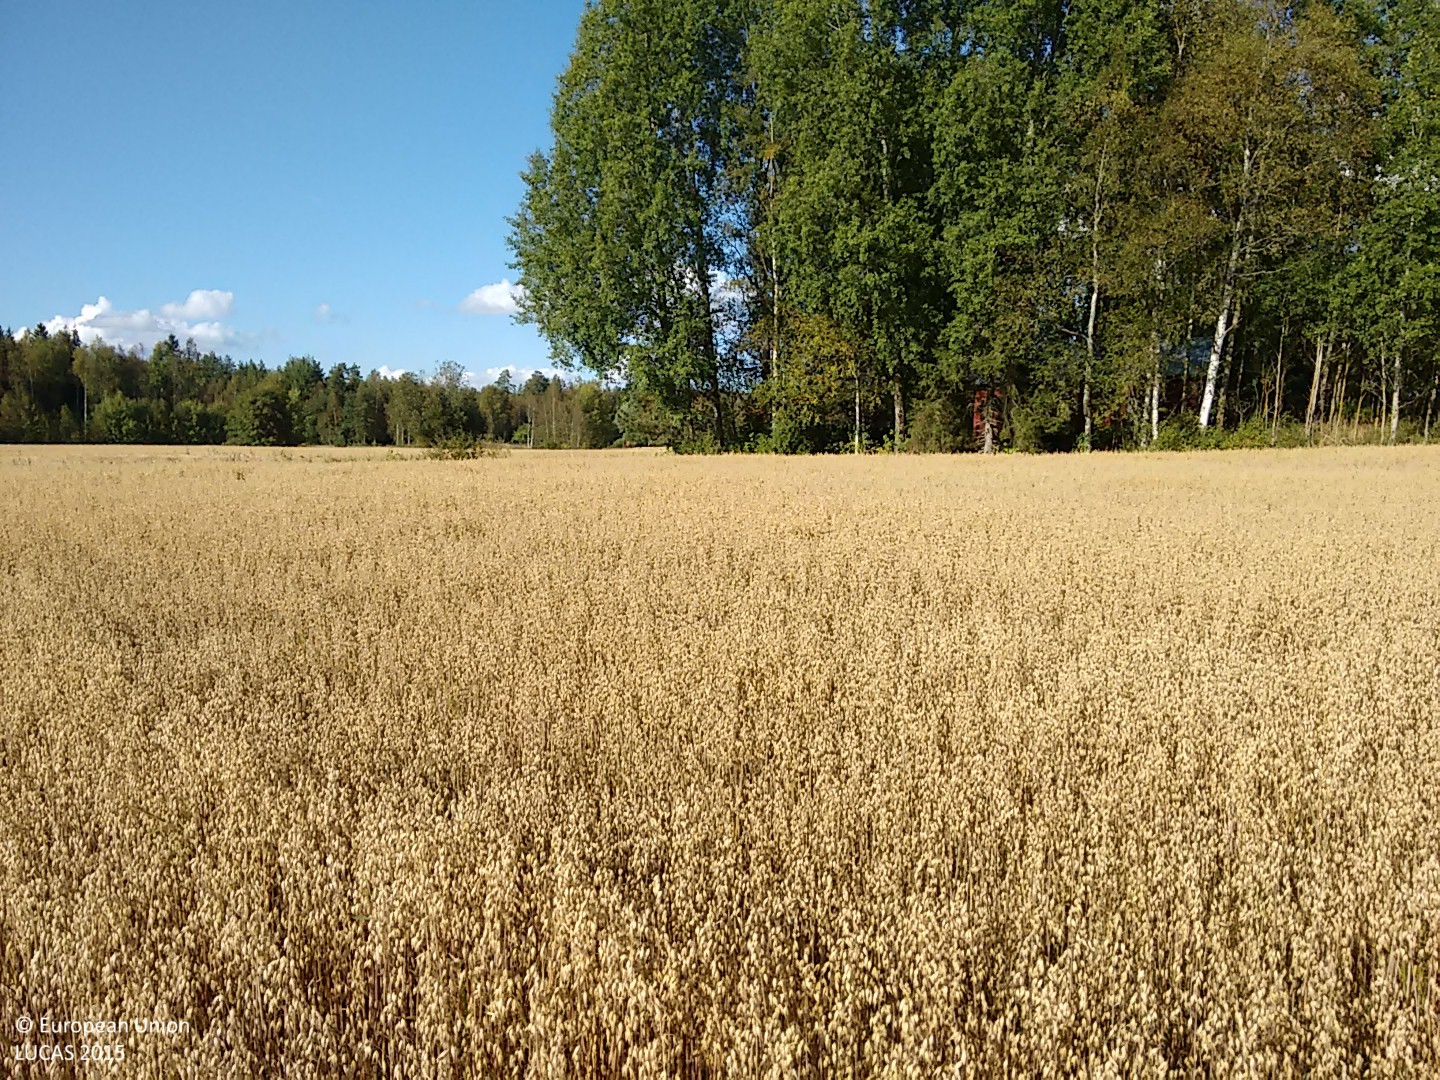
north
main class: Cropland
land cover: Oats
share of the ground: > 75 %
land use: Agriculture (excluding fallow land and kitchen gardens)
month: September
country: FI
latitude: 60.9643
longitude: 21.7485
